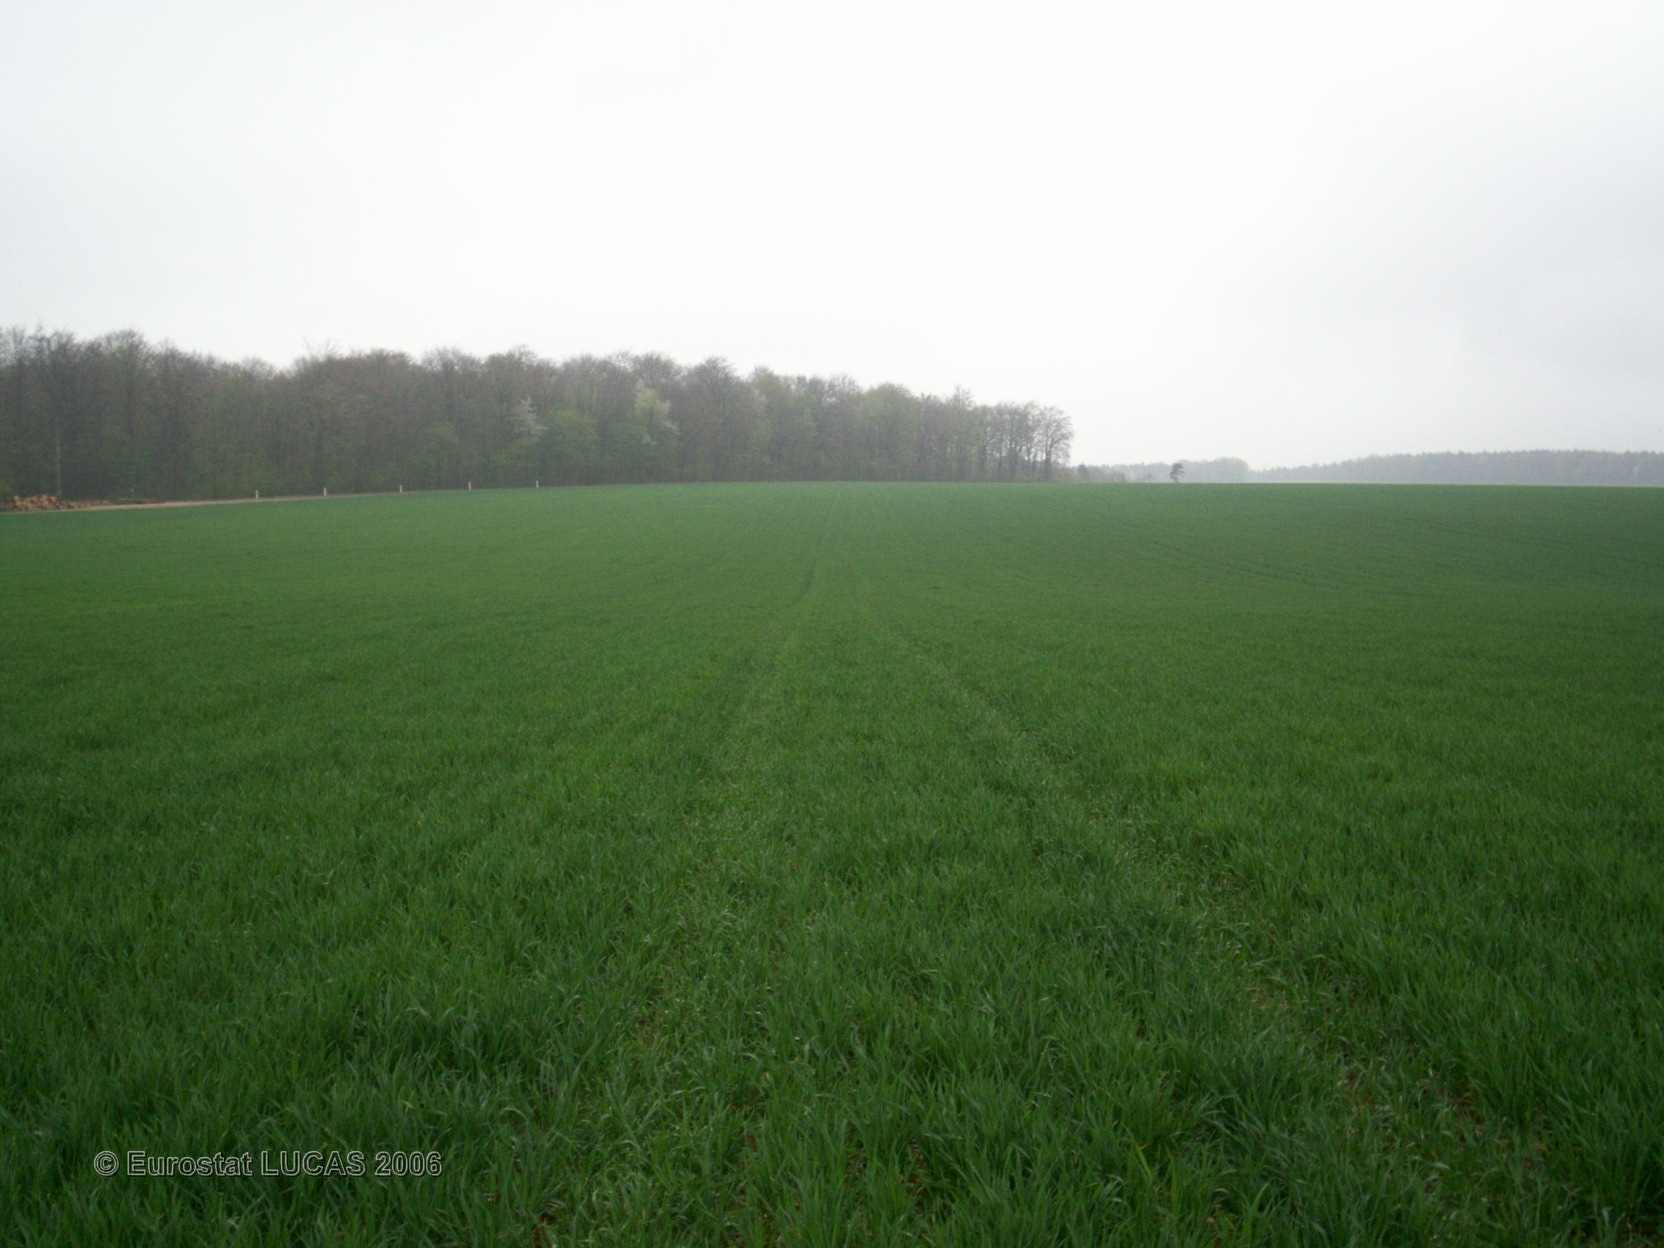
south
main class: Cropland
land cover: Common wheat
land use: Agriculture (excluding fallow land and kitchen gardens)
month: April
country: FR
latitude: 47.7803
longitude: 4.5132
